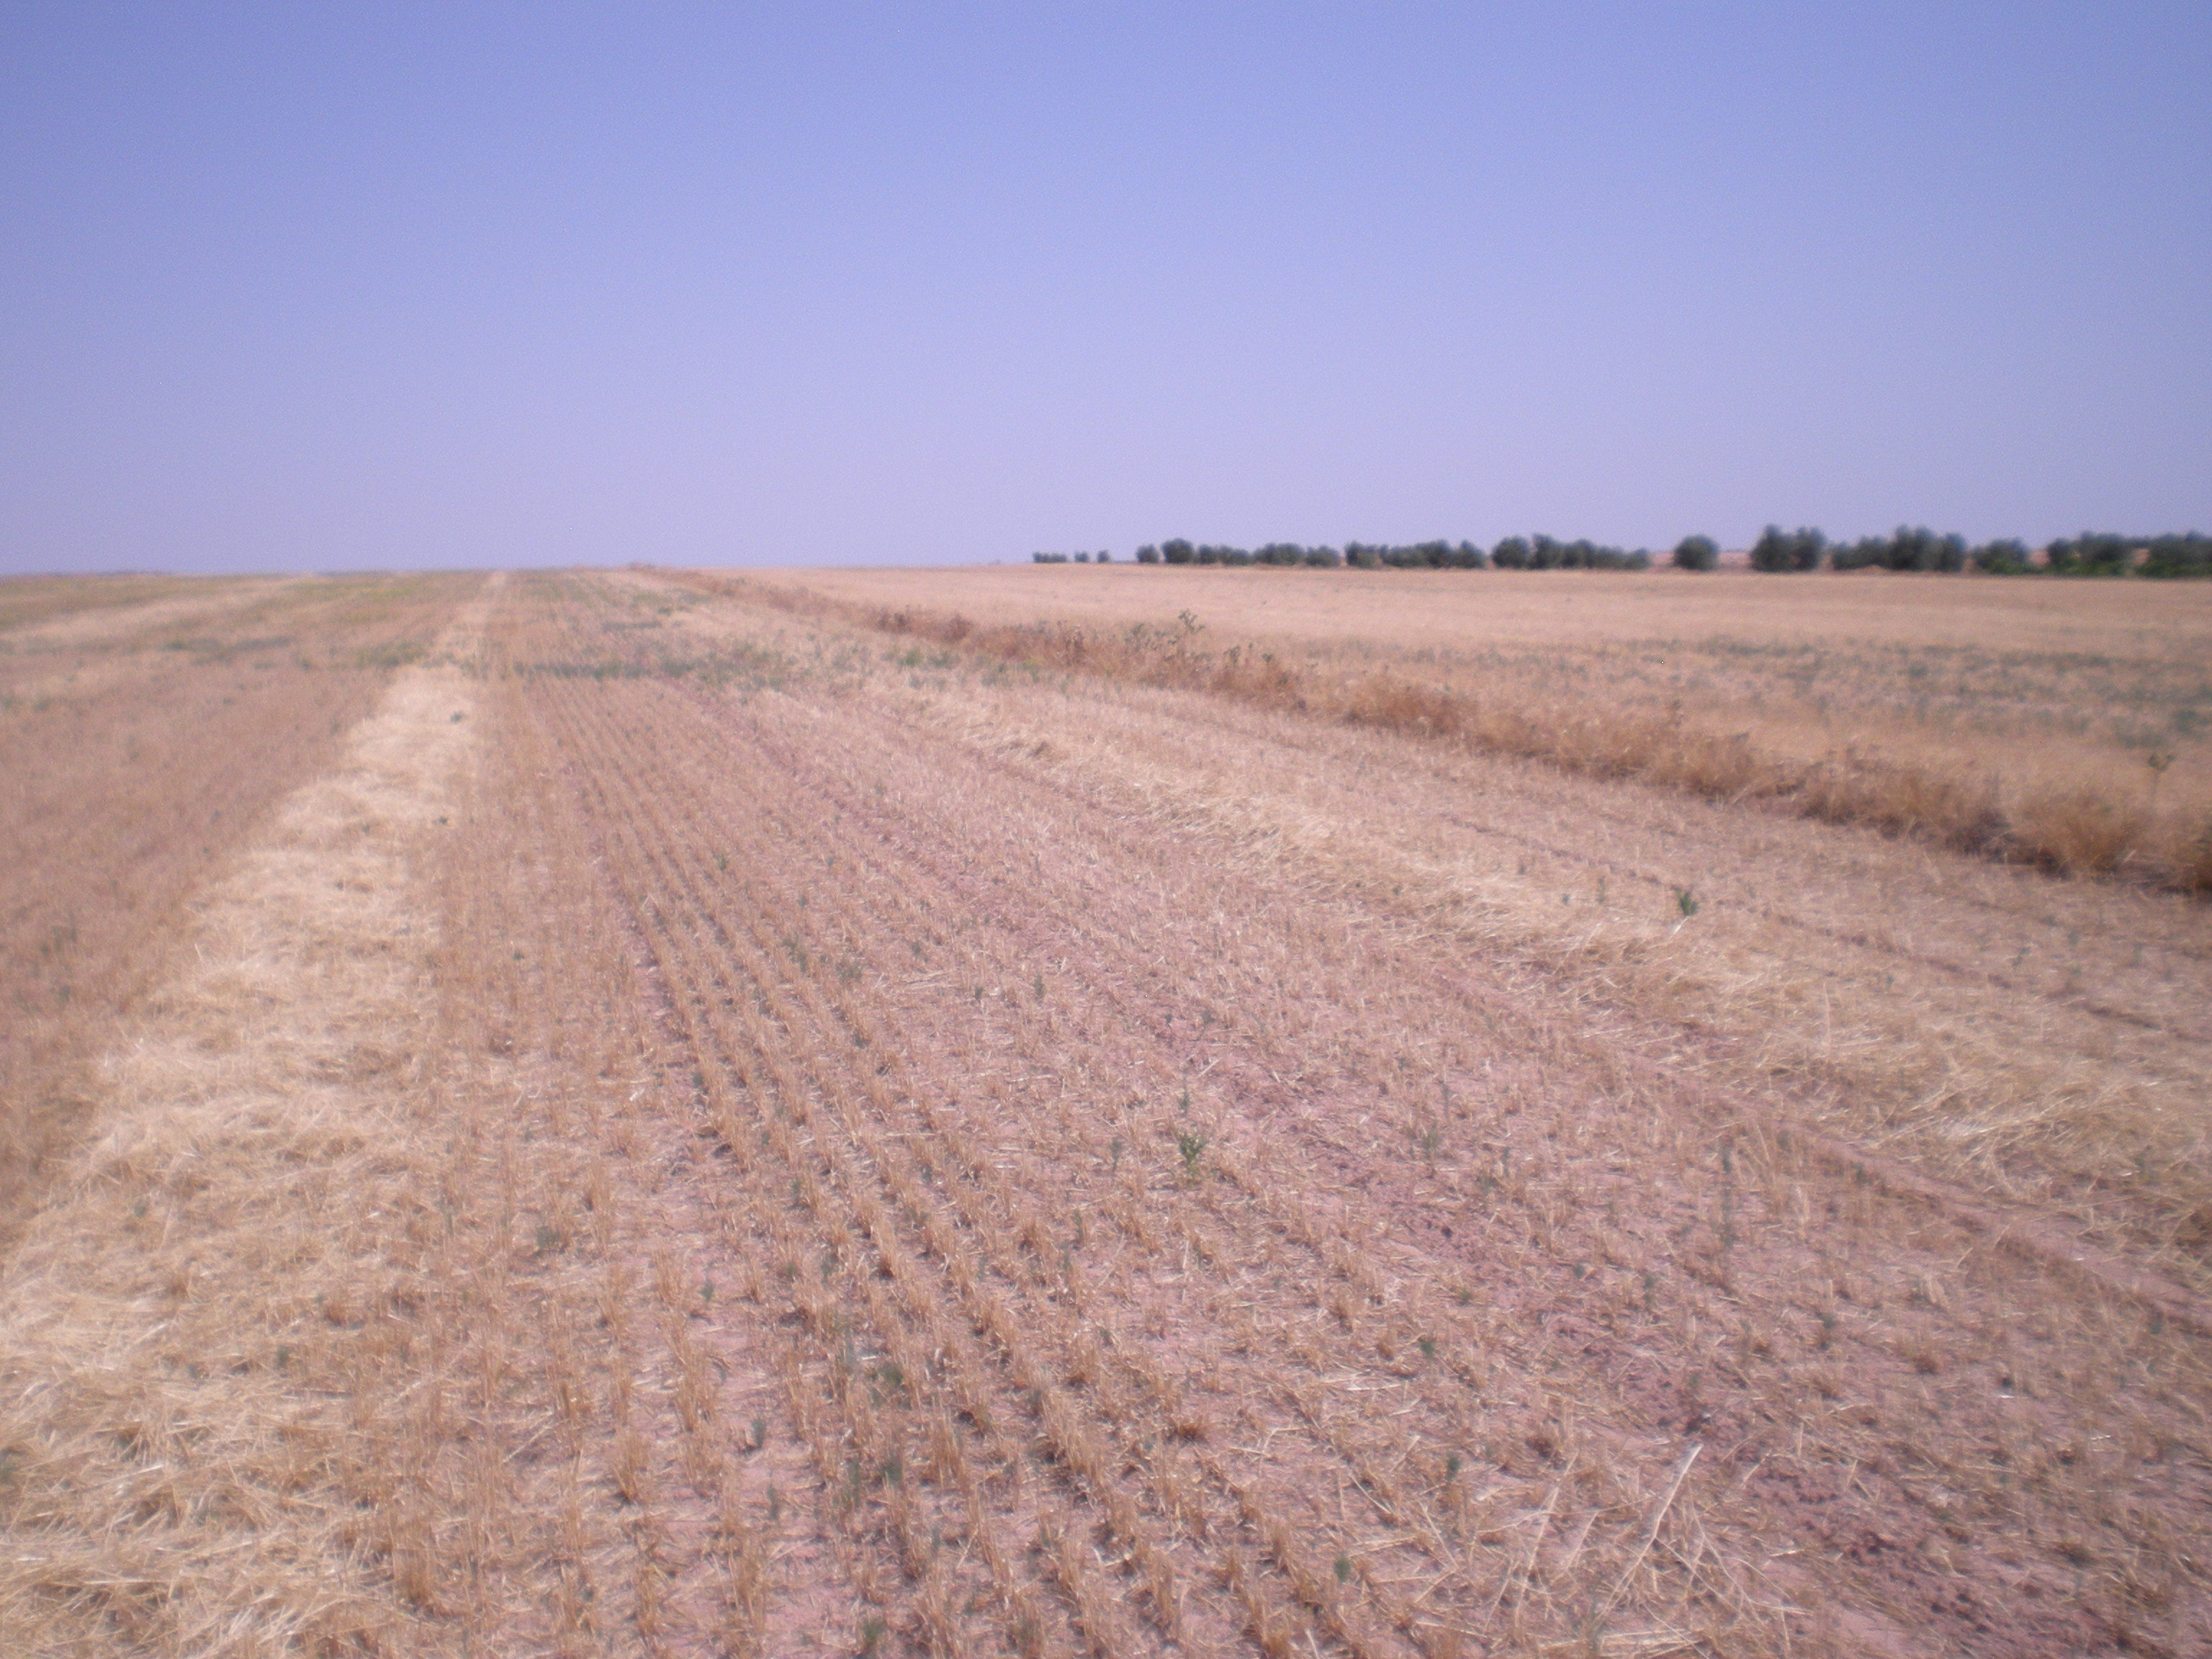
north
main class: Cropland
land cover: Barley
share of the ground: < 10 %
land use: Agriculture (excluding fallow land and kitchen gardens)
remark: Harvested field
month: July
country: ES
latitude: 39.4990
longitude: -3.3357
